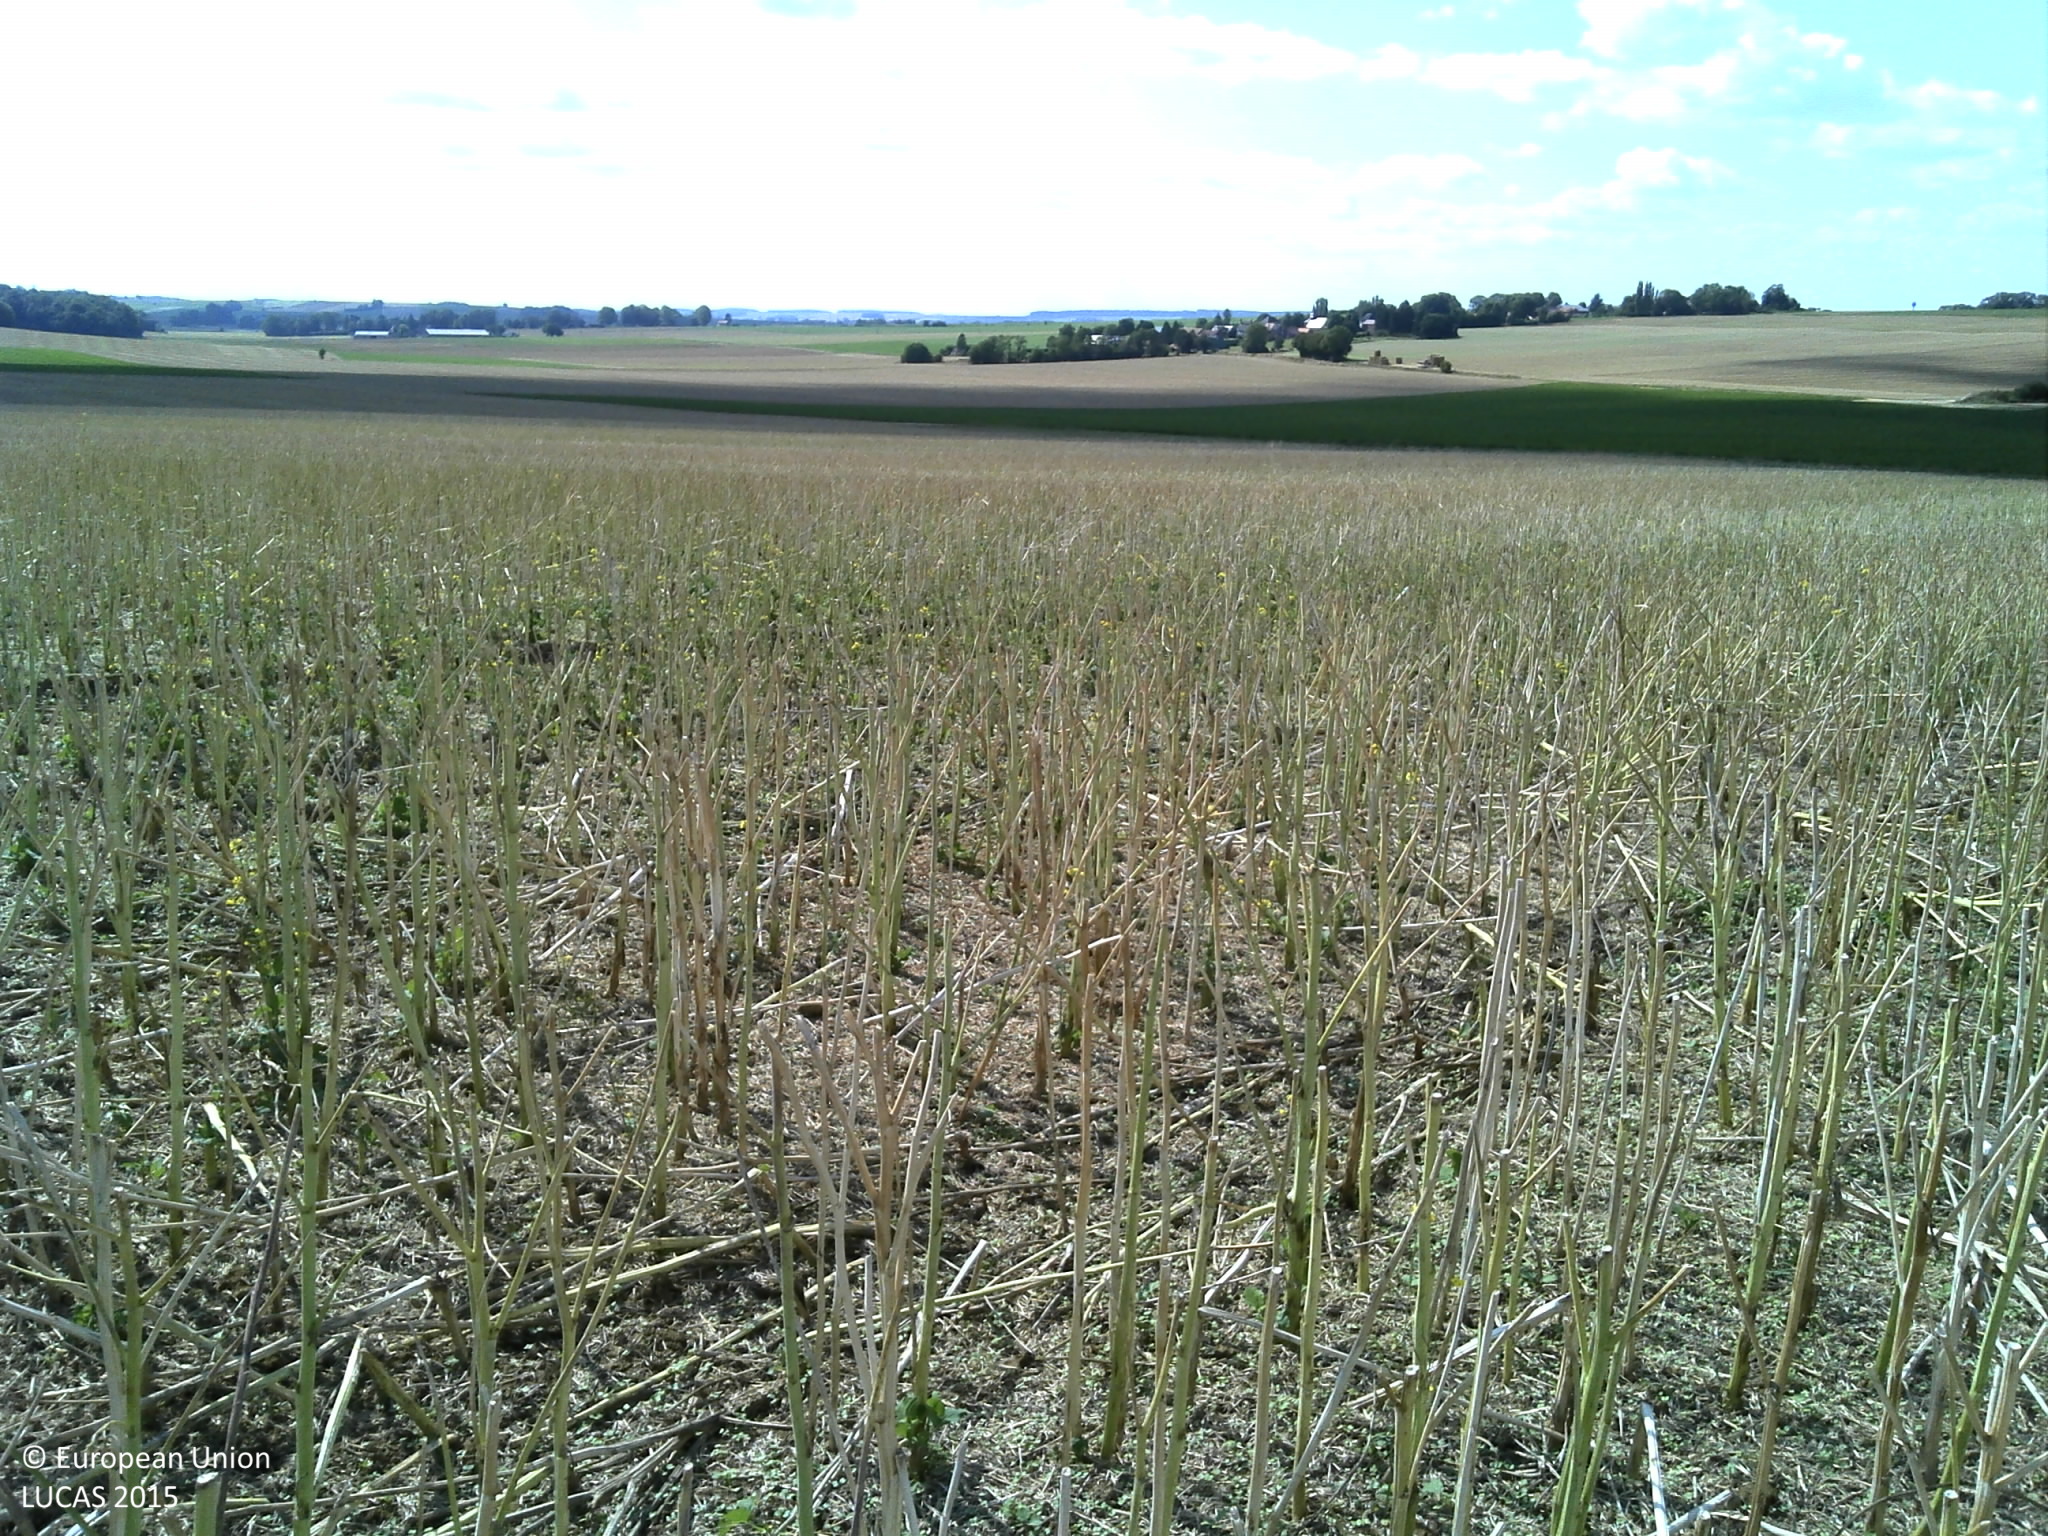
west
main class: Cropland
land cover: Rape and turnip rape
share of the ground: 10 - 25 %
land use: Agriculture (excluding fallow land and kitchen gardens)
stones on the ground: < 10 %
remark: Harvested field
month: August
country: FR
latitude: 49.9420
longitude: 3.1492
